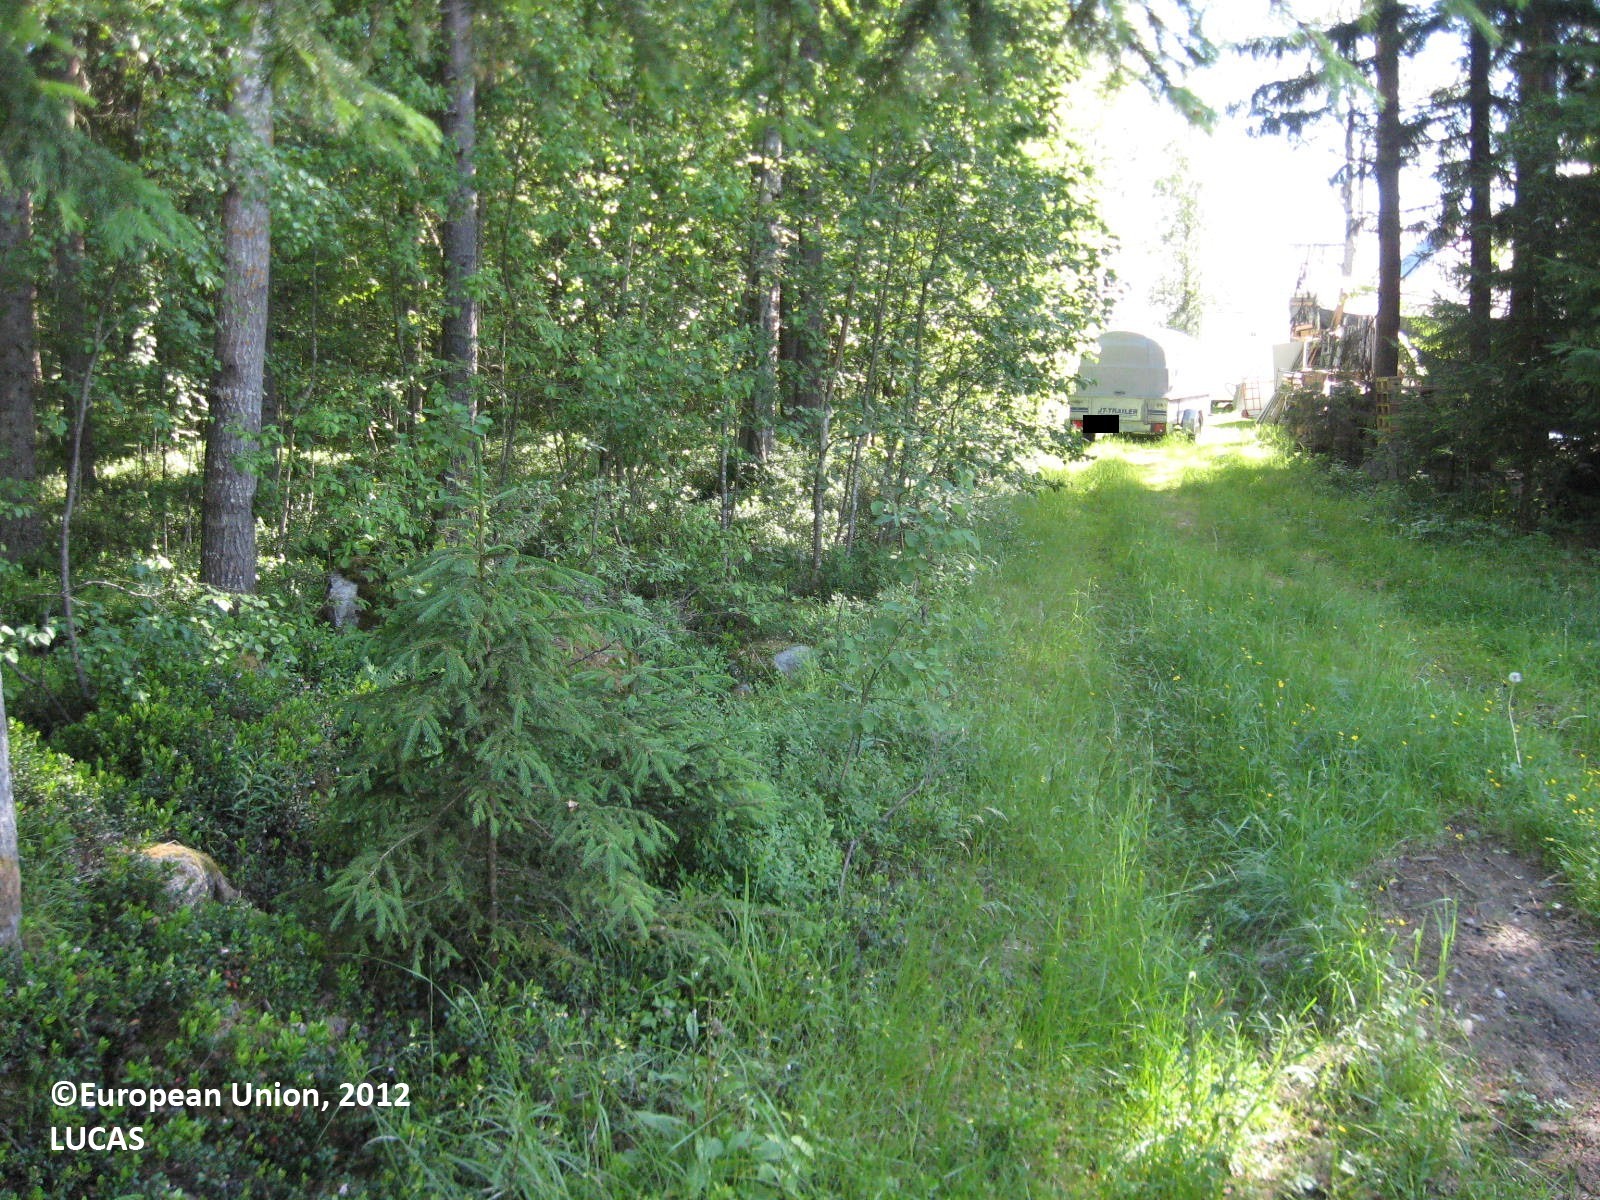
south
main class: Woodland
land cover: Pine dominated mixed woodland
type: boreal forest
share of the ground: > 75 %
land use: Forestry
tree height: > 5 m
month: July
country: FI
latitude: 62.5932
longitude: 22.8144
